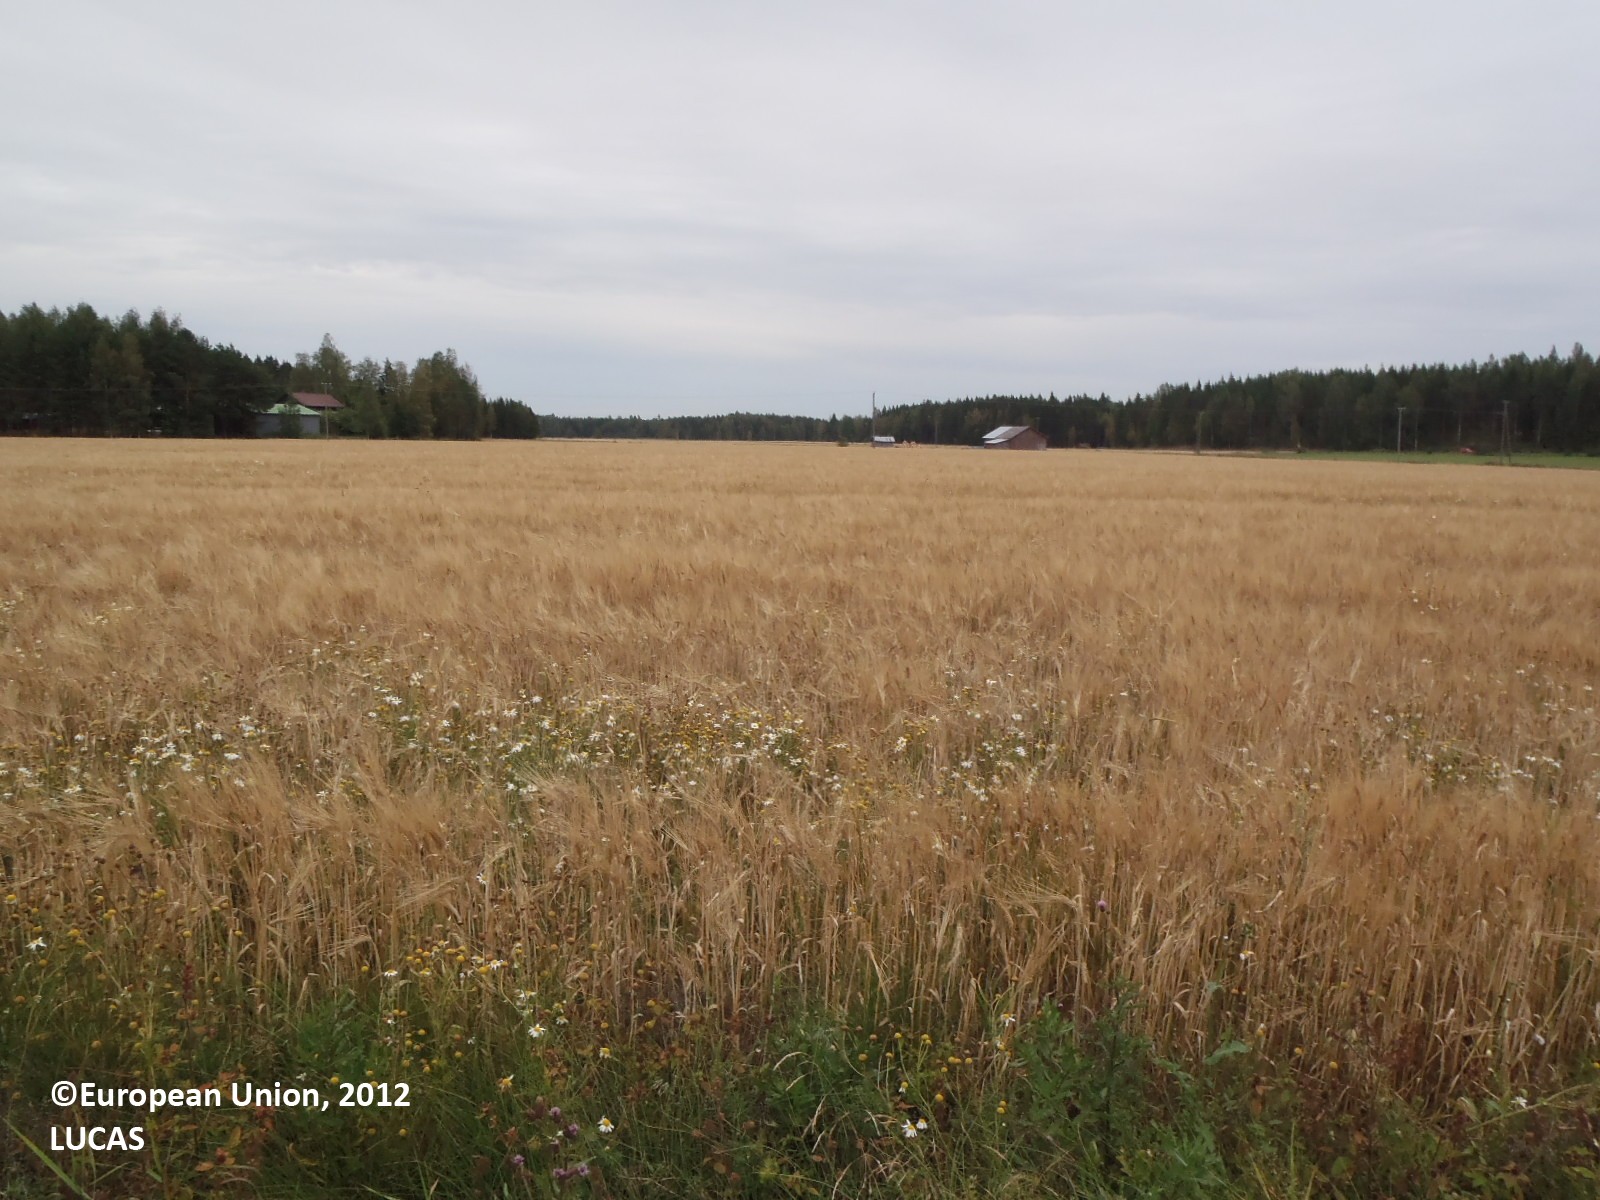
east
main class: Cropland
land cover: Barley
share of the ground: > 75 %
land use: Agriculture (excluding fallow land and kitchen gardens)
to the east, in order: Barley; Grass margins; Ditches and canals; Grass margins; Barley; Electric lines; Barley; Grass margins; Ditches and canals; Grass margins; Oats
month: August
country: FI
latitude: 60.8194
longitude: 22.5908
